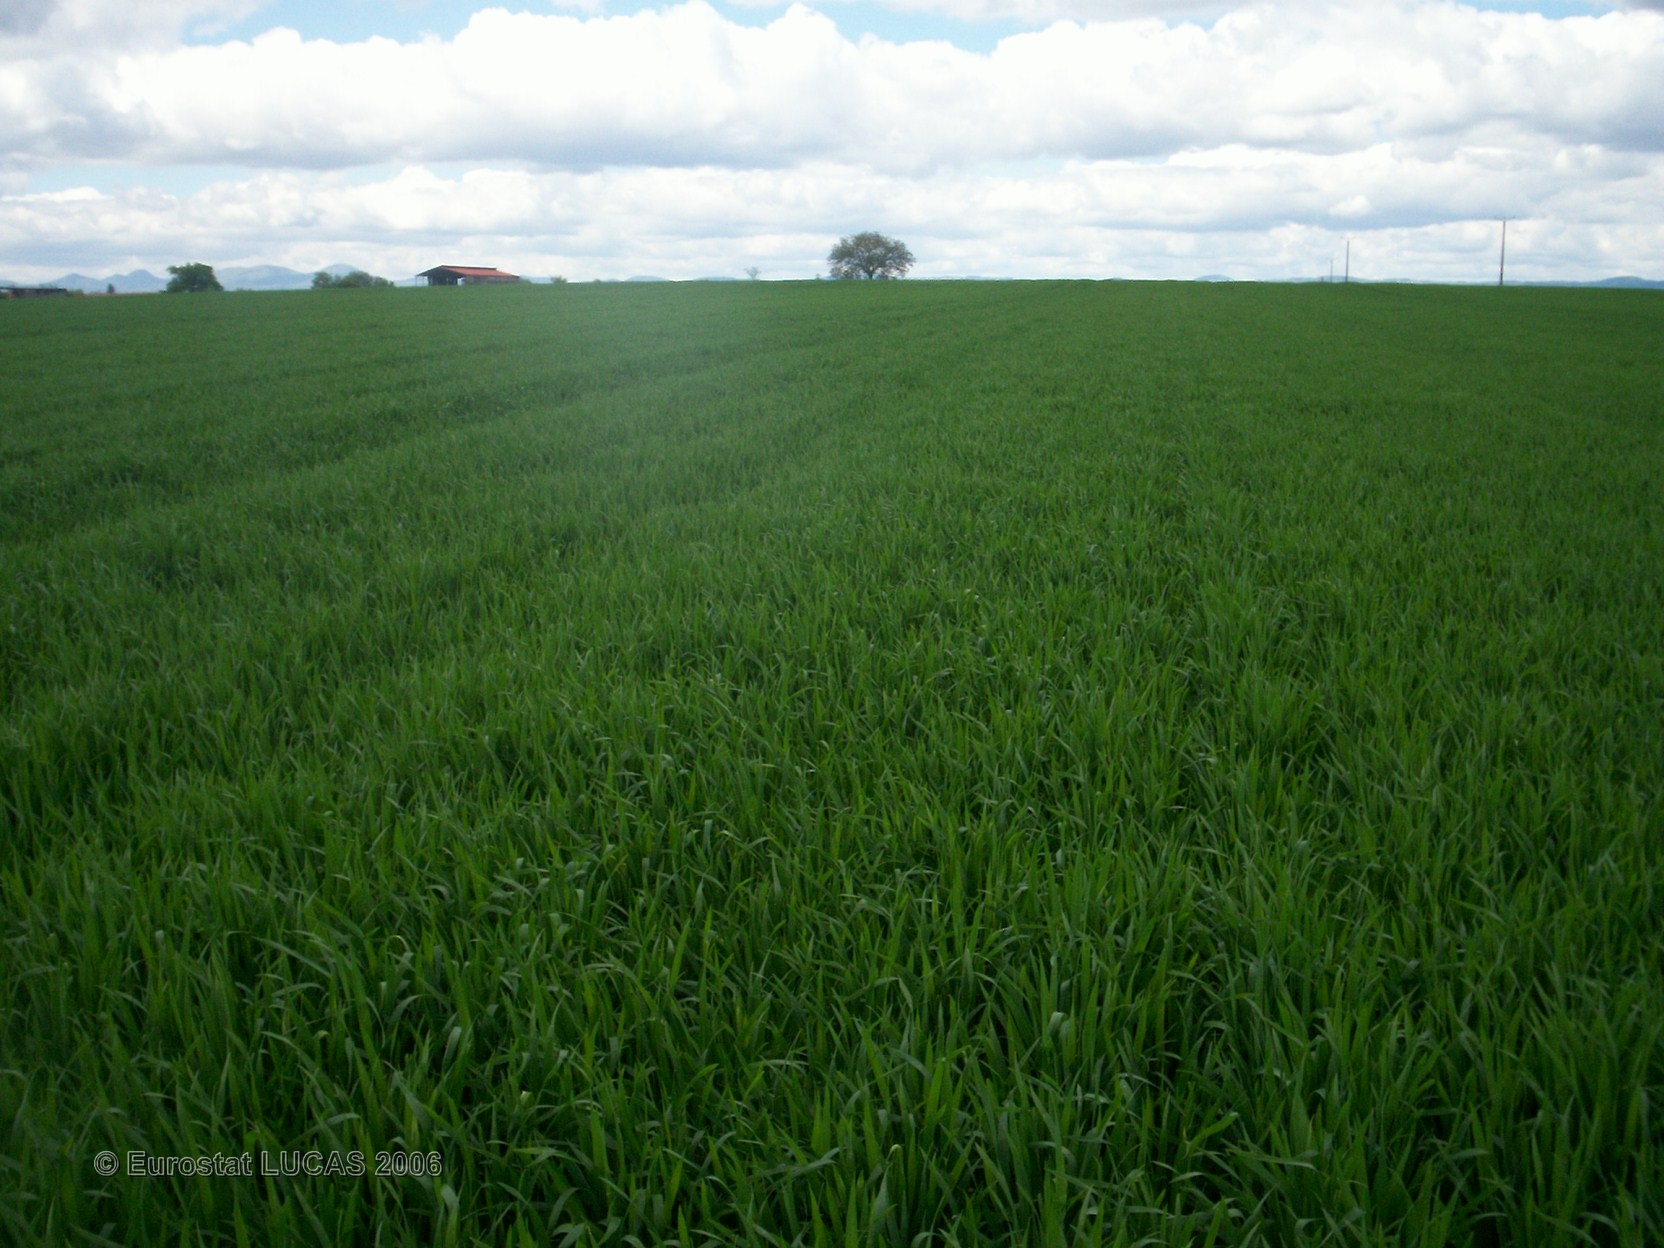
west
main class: Cropland
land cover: Common wheat
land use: Agriculture (excluding fallow land and kitchen gardens)
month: May
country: FR
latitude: 45.9214
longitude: 3.2561
